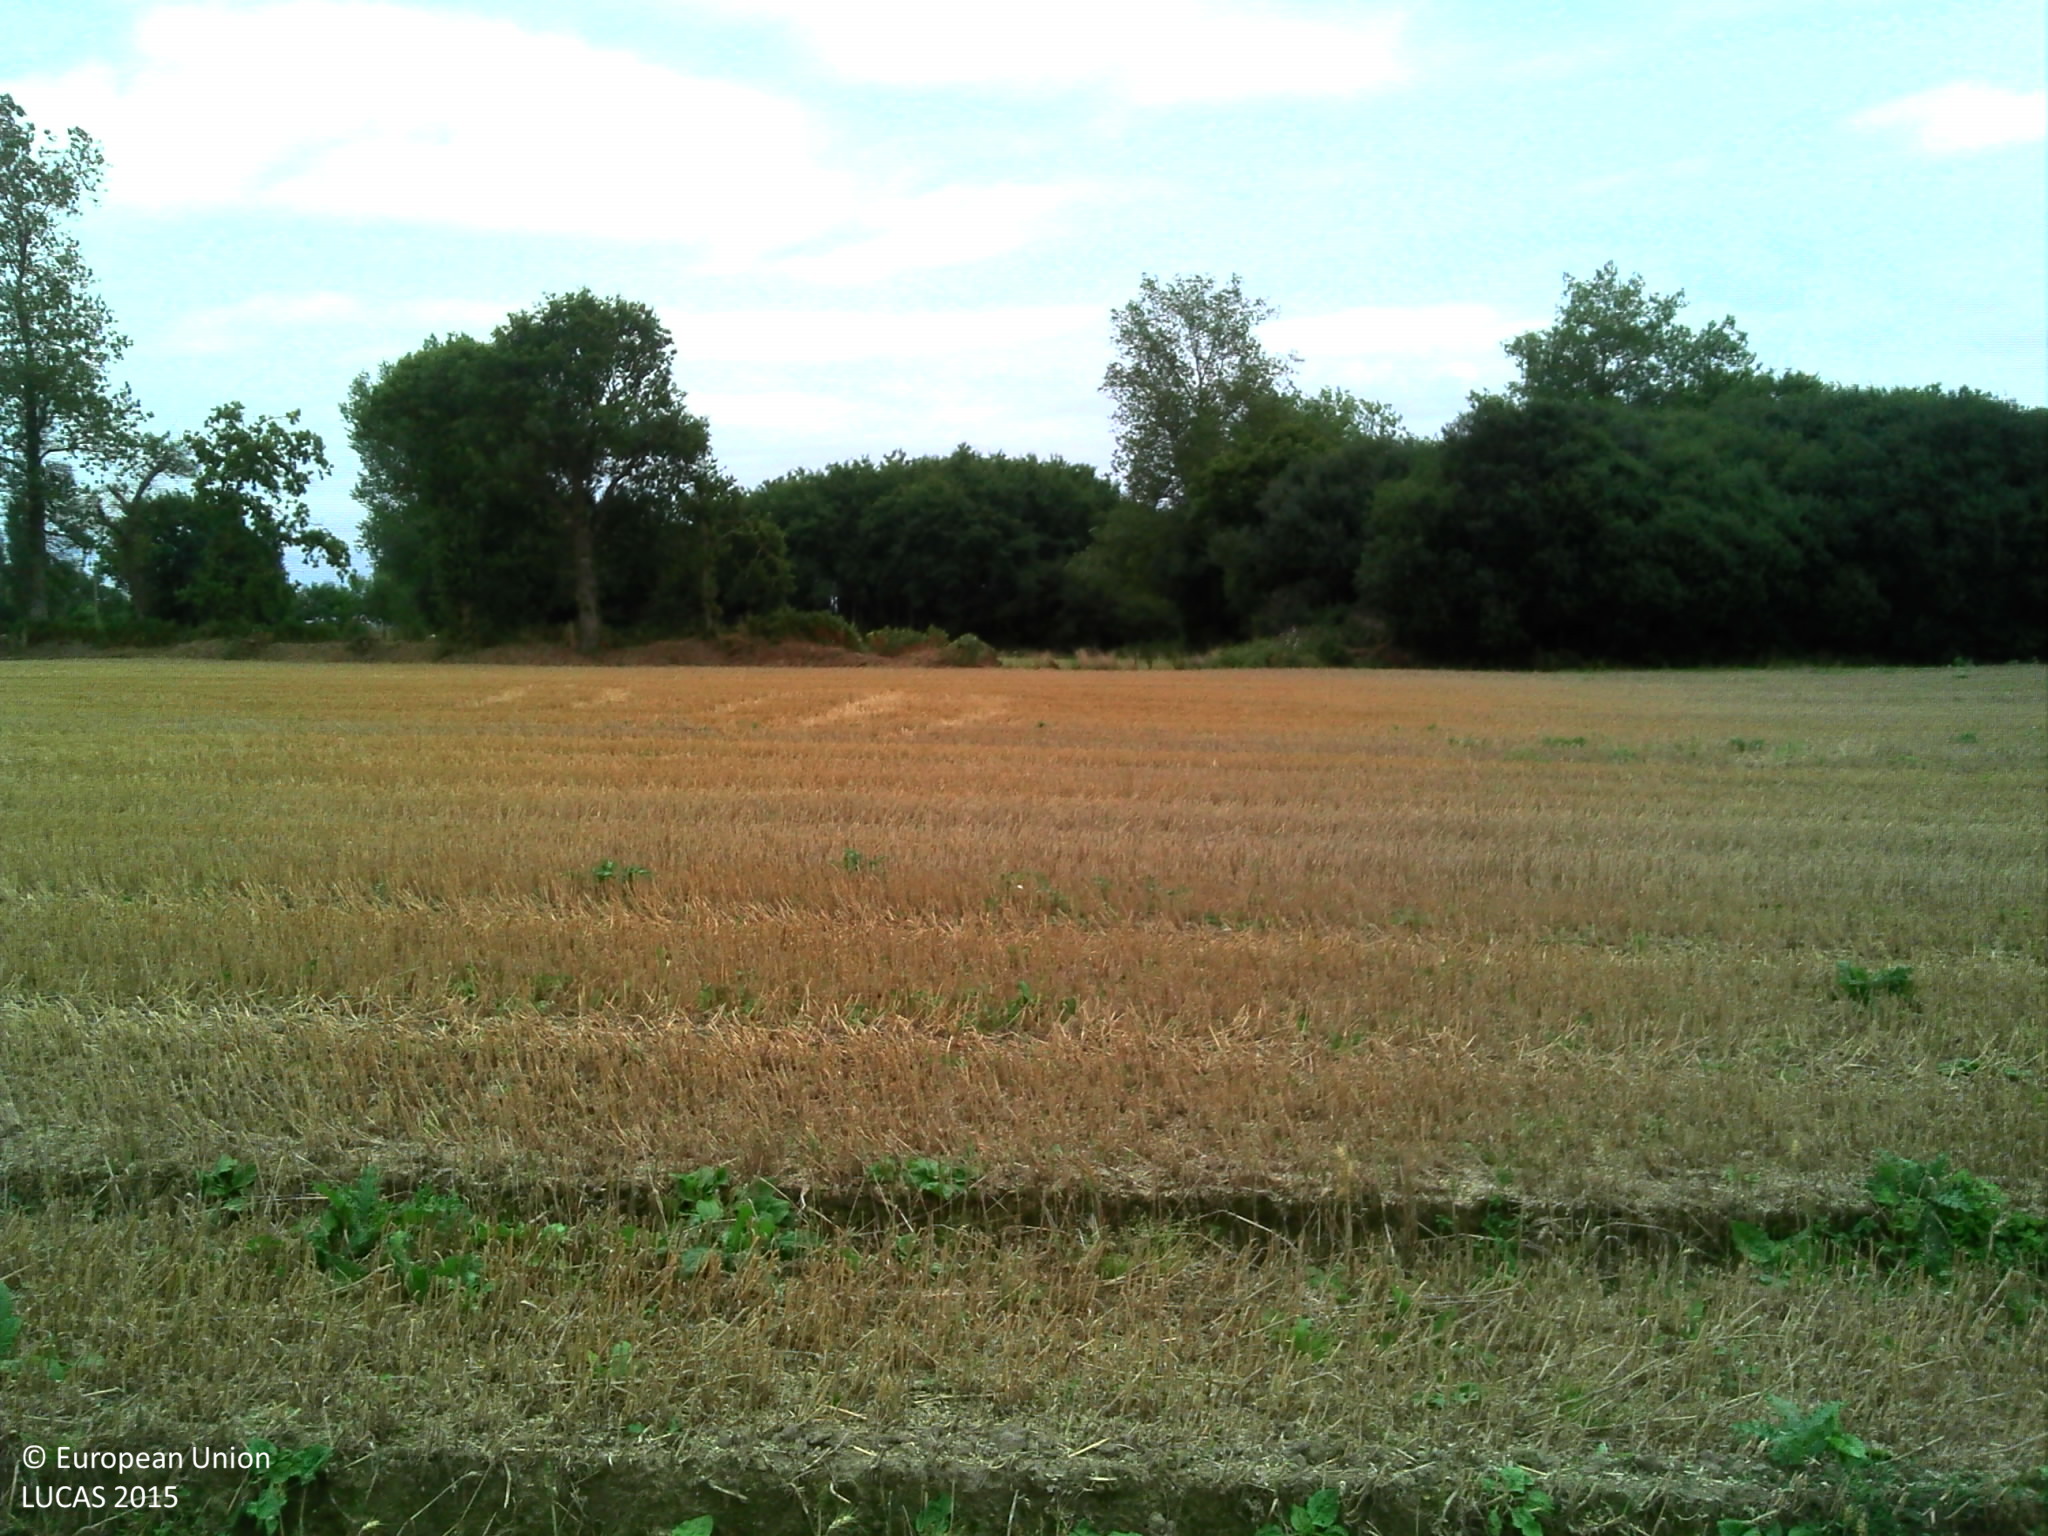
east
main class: Cropland
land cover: Common wheat
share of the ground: > 75 %
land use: Agriculture (excluding fallow land and kitchen gardens)
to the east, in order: Common wheat; Grass margins; Ditches and canals; Lines of trees; Grass margins; Tracks; Grass margins; Fences; Grassland without tree/shrub cover; Fences; Broadleaved woodland; Ditches and canals; Grass margins; Tracks; Grass margins; Ditches and canals; Common wheat
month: August
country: FR
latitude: 48.6824
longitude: -3.2086
